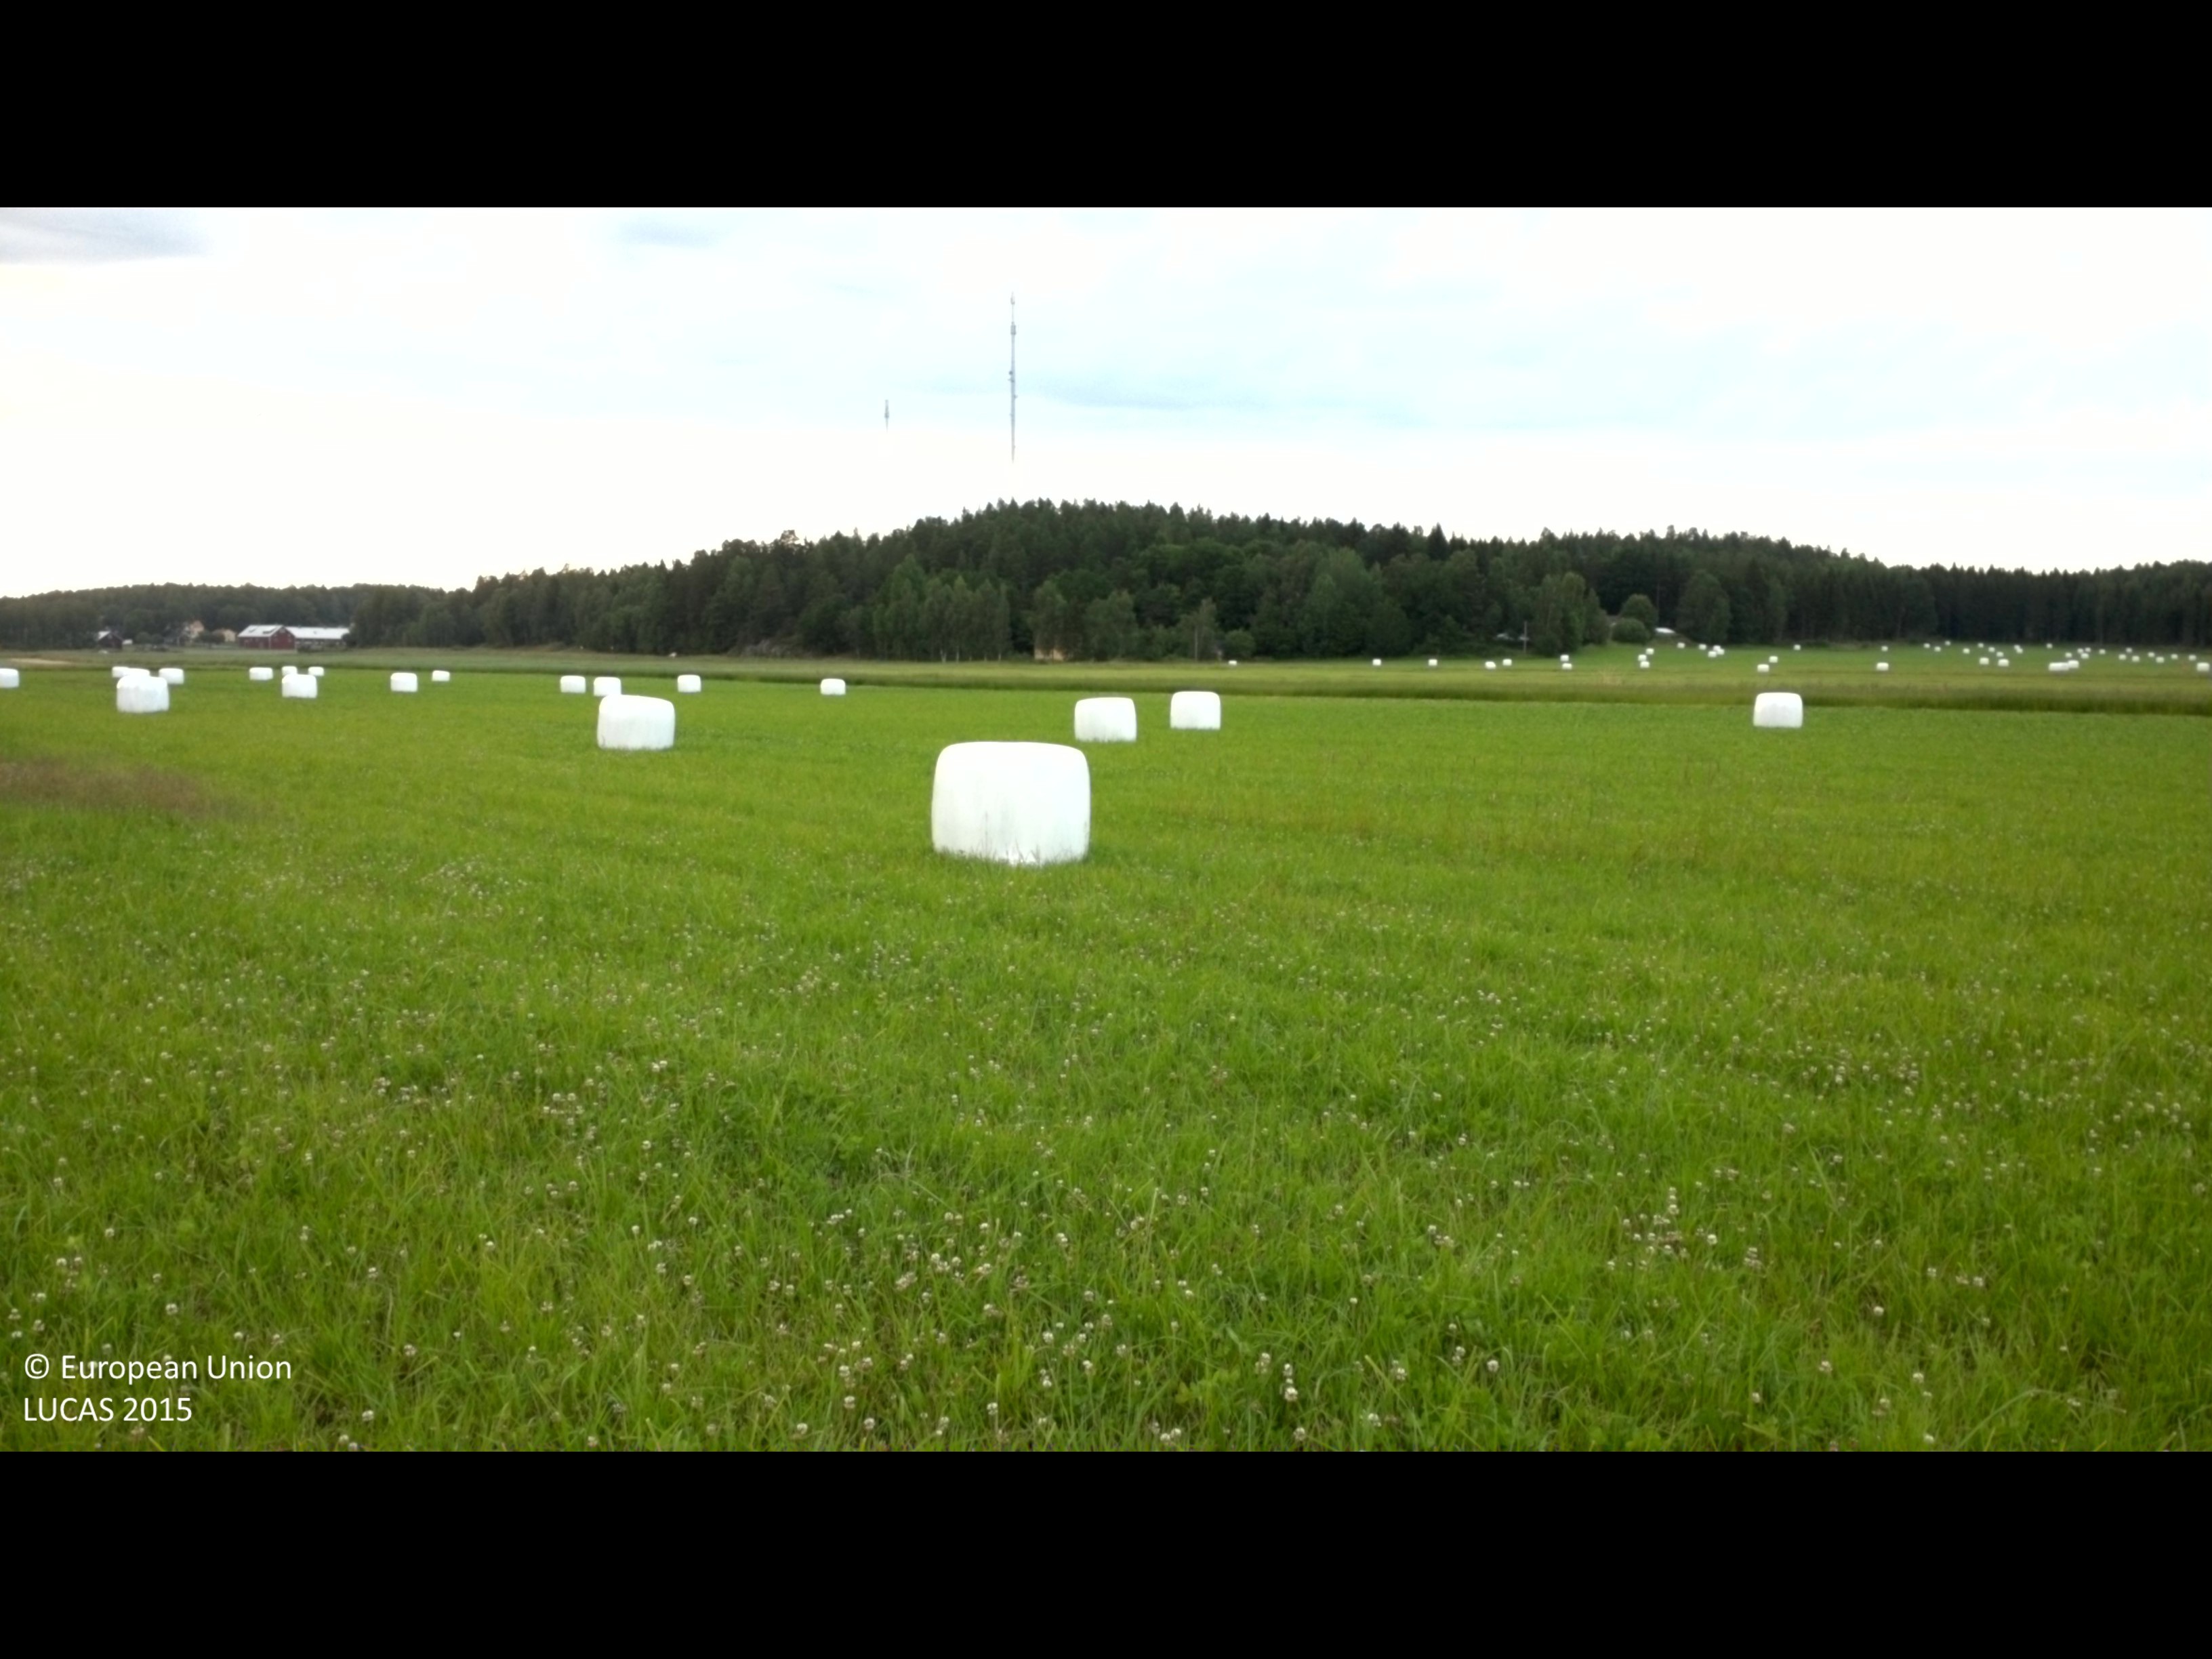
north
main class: Cropland
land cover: Other leguminous and mixtures for fodder
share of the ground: > 75 %
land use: Agriculture (excluding fallow land and kitchen gardens)
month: July
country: SE
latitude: 58.3866
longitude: 16.5132
